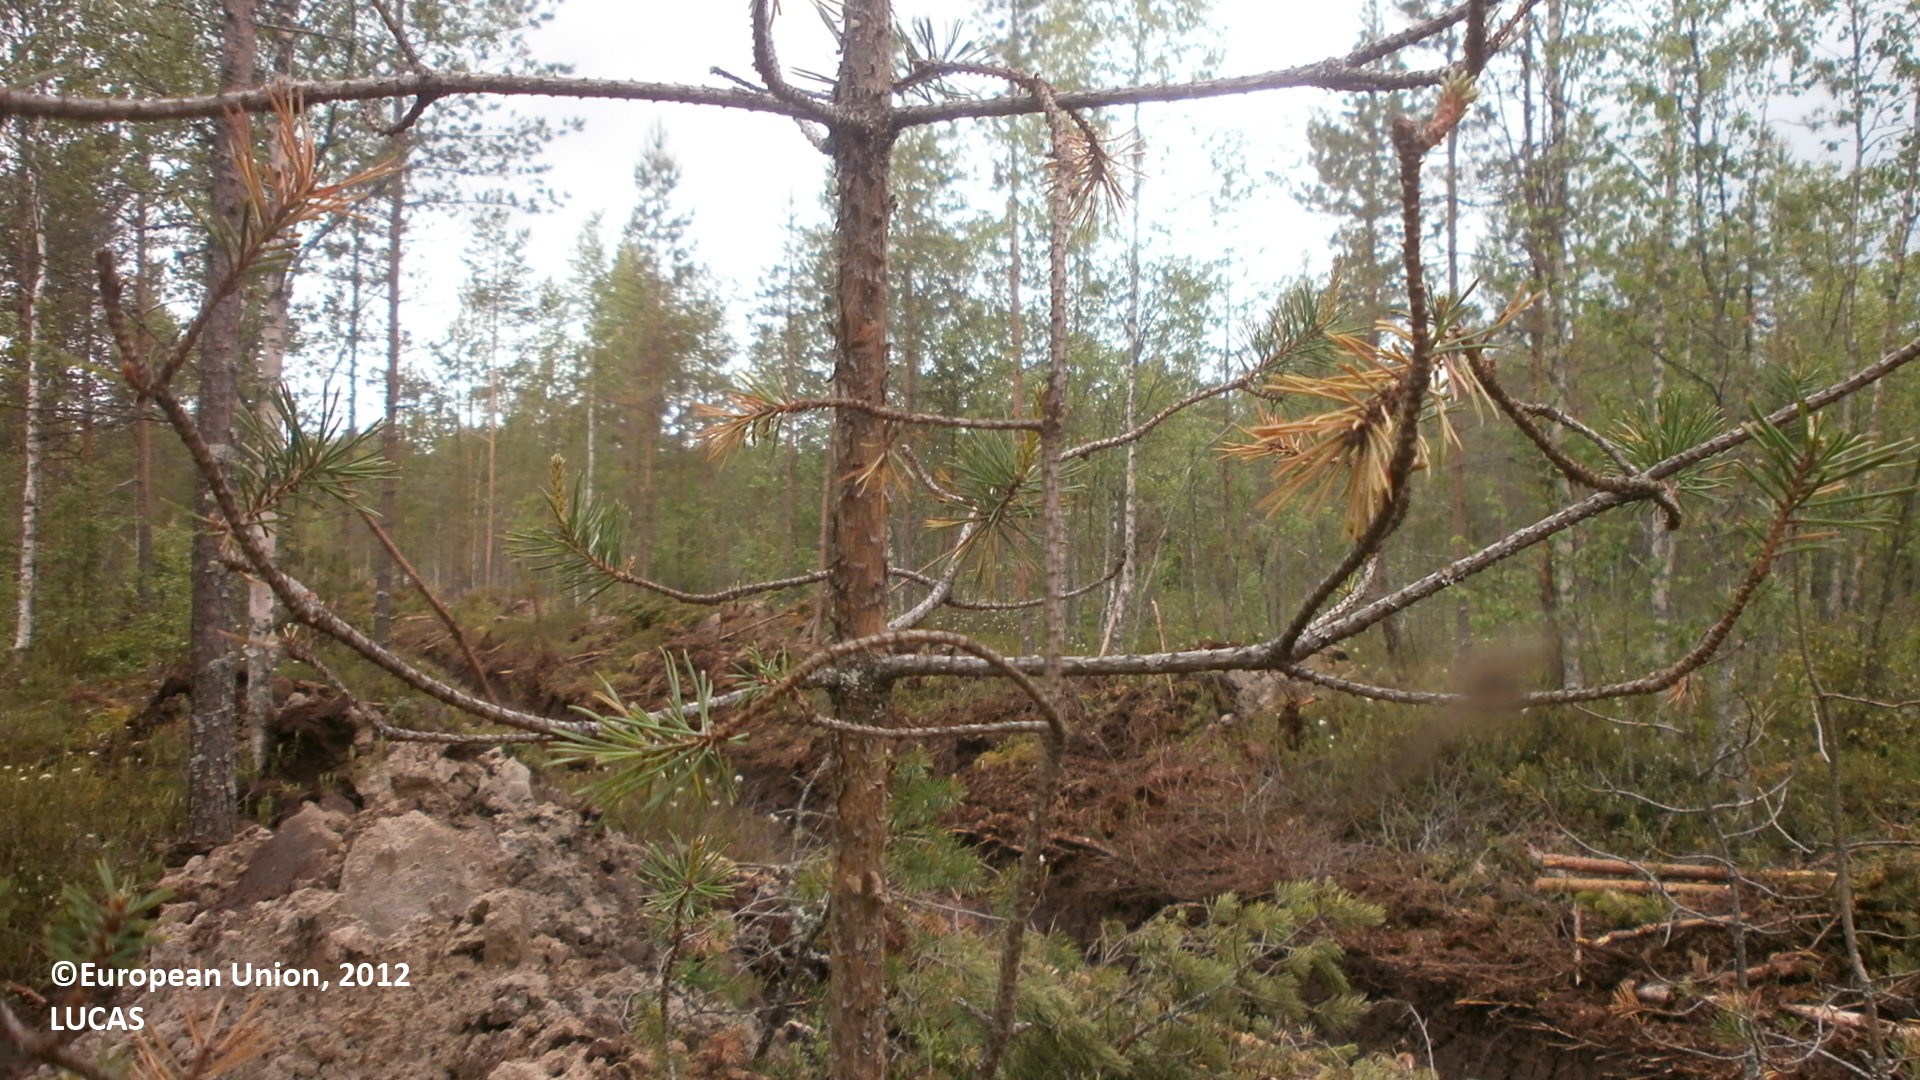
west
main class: Woodland
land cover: Pine dominated coniferous woodland
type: mire and swamp forests
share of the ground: 50 - 75 %
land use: Forestry
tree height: > 5 m
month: June
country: FI
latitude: 64.2830
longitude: 25.0576
